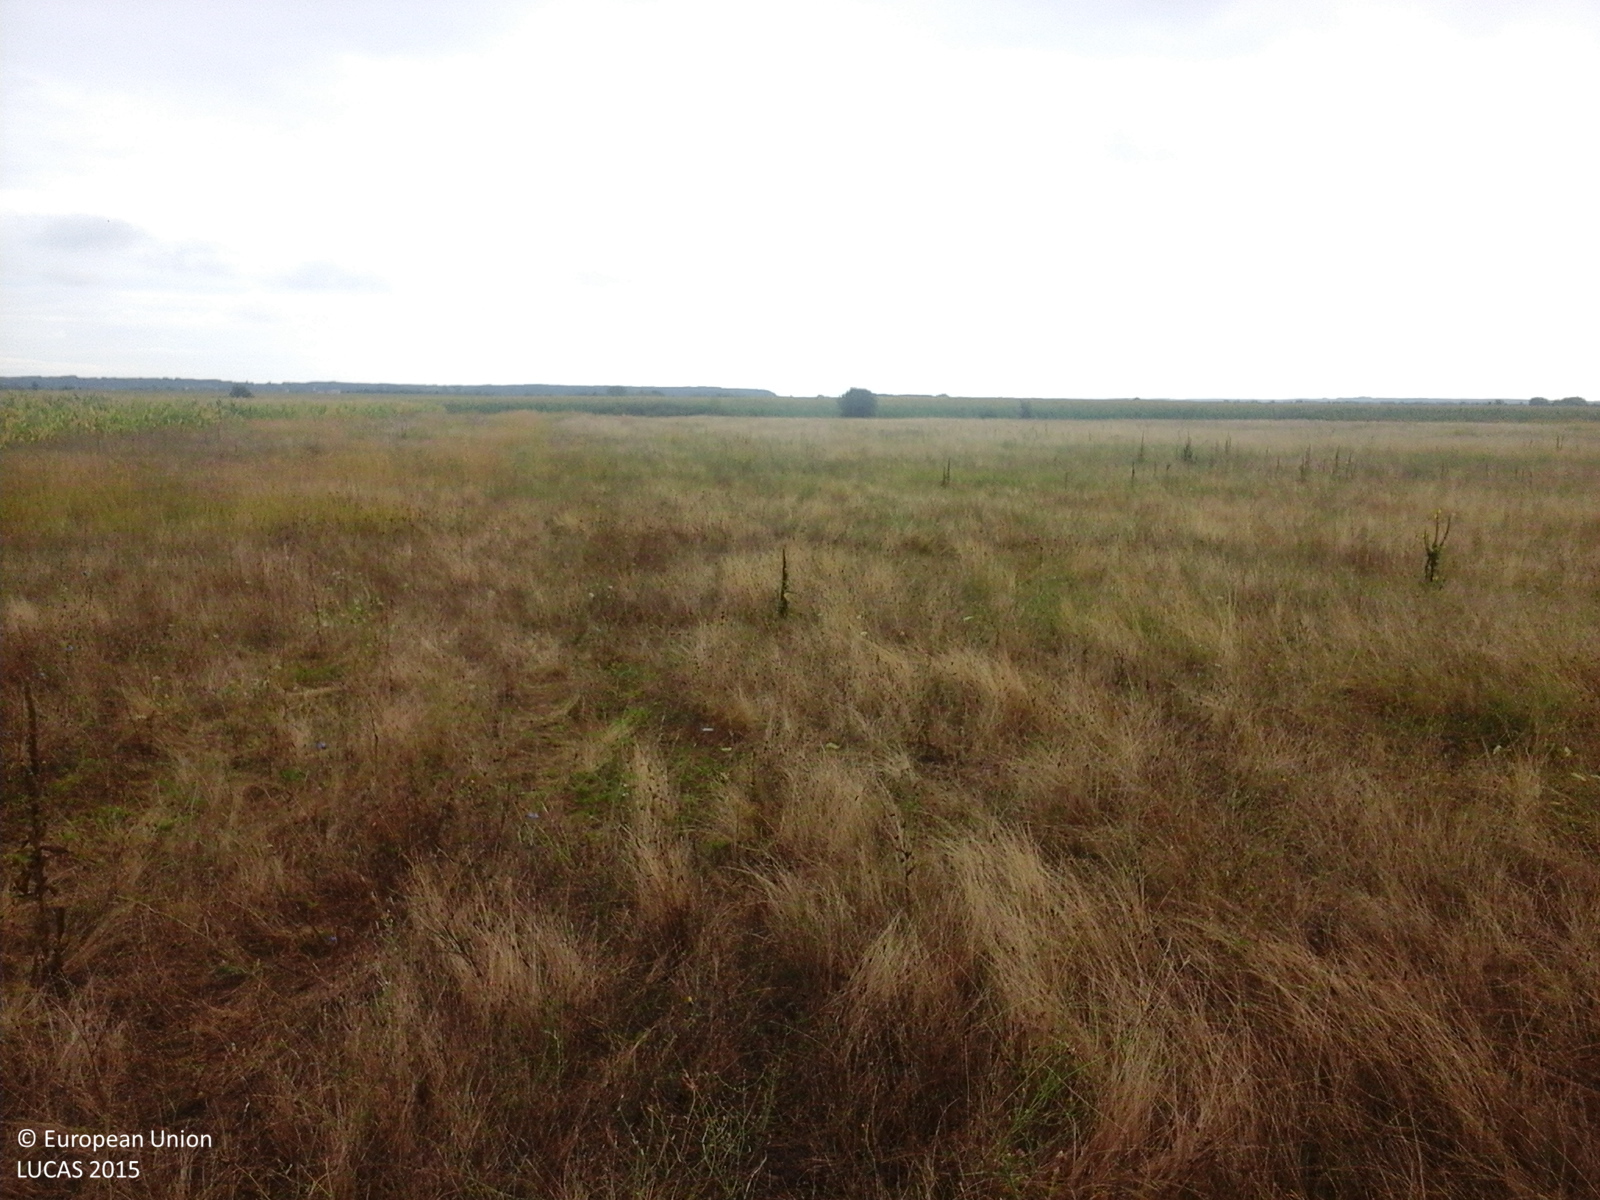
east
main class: Grassland
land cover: Grassland without tree/shrub cover
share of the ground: > 75 %
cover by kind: herbaceous plants 100 %
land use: Agriculture (excluding fallow land and kitchen gardens)
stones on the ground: < 10 %
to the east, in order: Grassland without tree/shrub cover; Ditches and canals; Grass margins; Maize
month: August
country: RO
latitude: 45.7416
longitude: 21.3812
